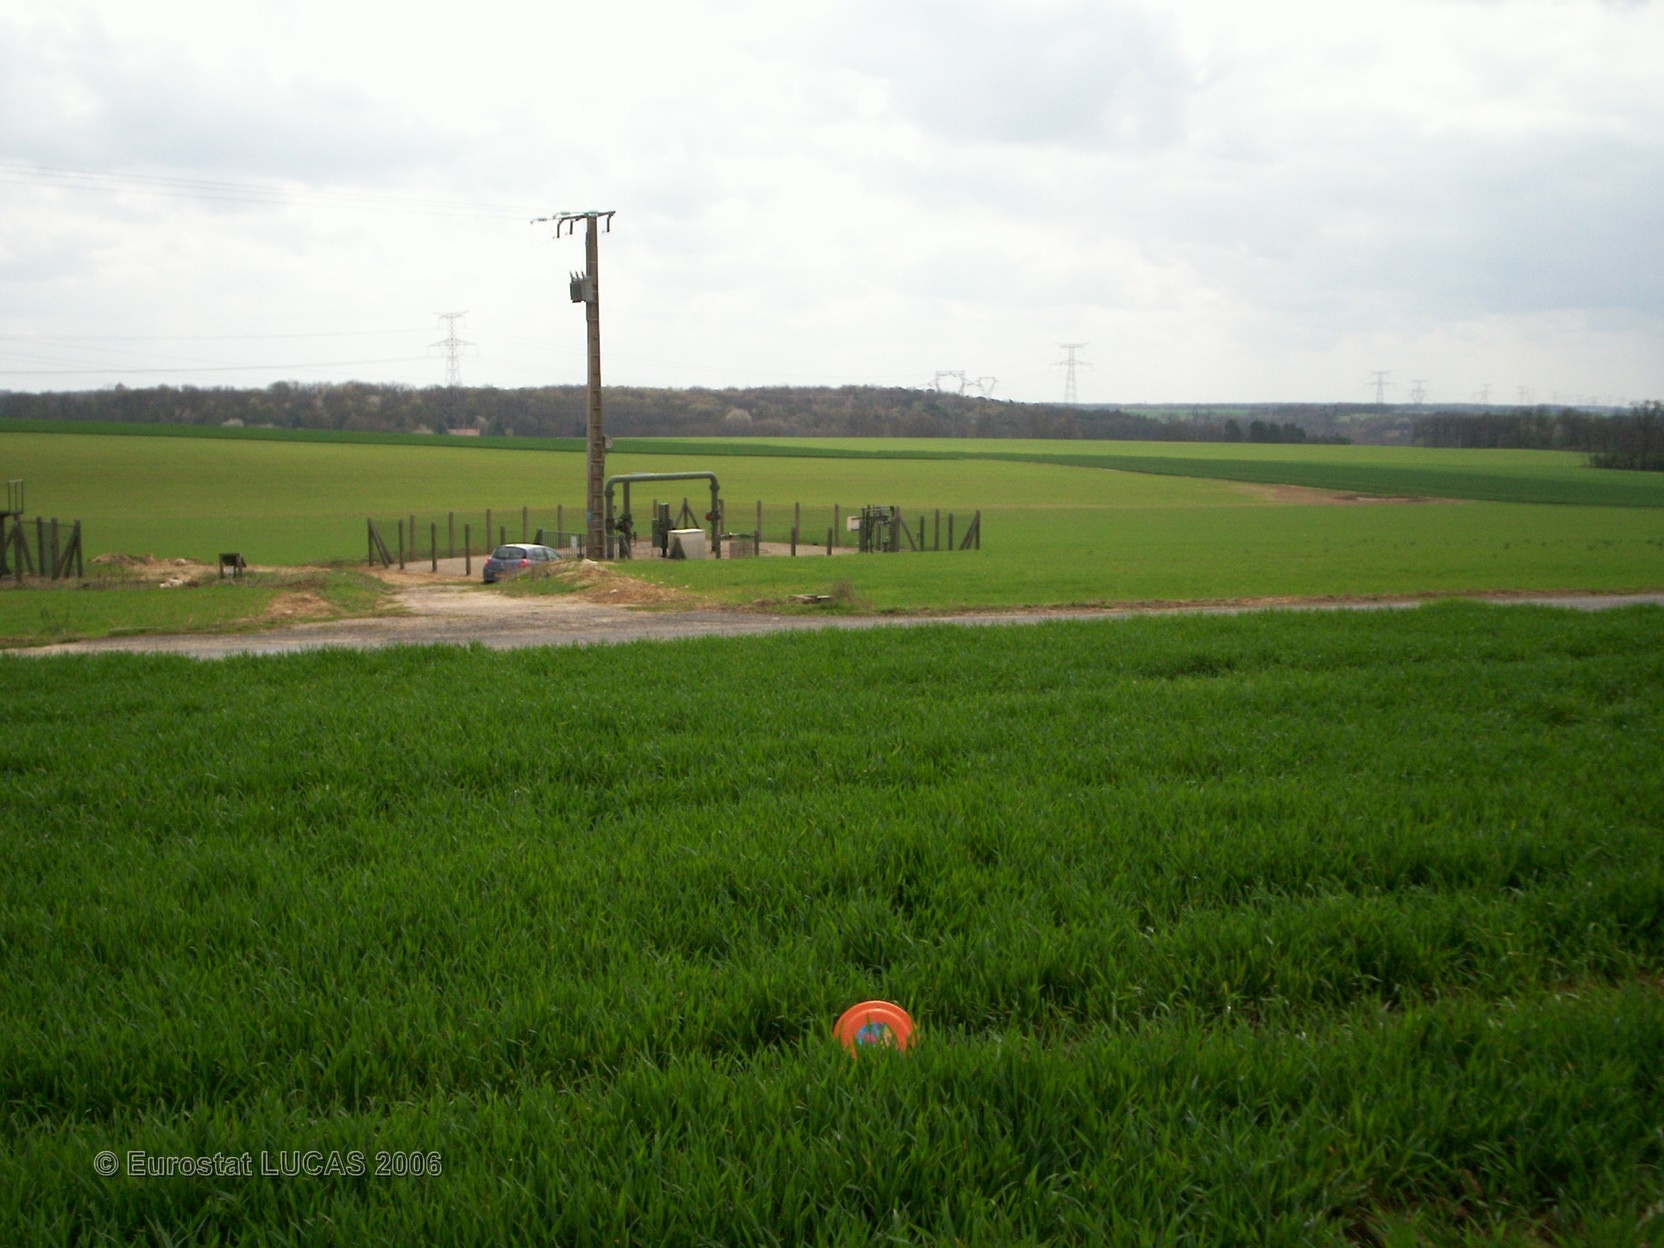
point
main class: Cropland
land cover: Common wheat
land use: Agriculture (excluding fallow land and kitchen gardens)
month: April
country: FR
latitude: 48.2615
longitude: 2.8387
